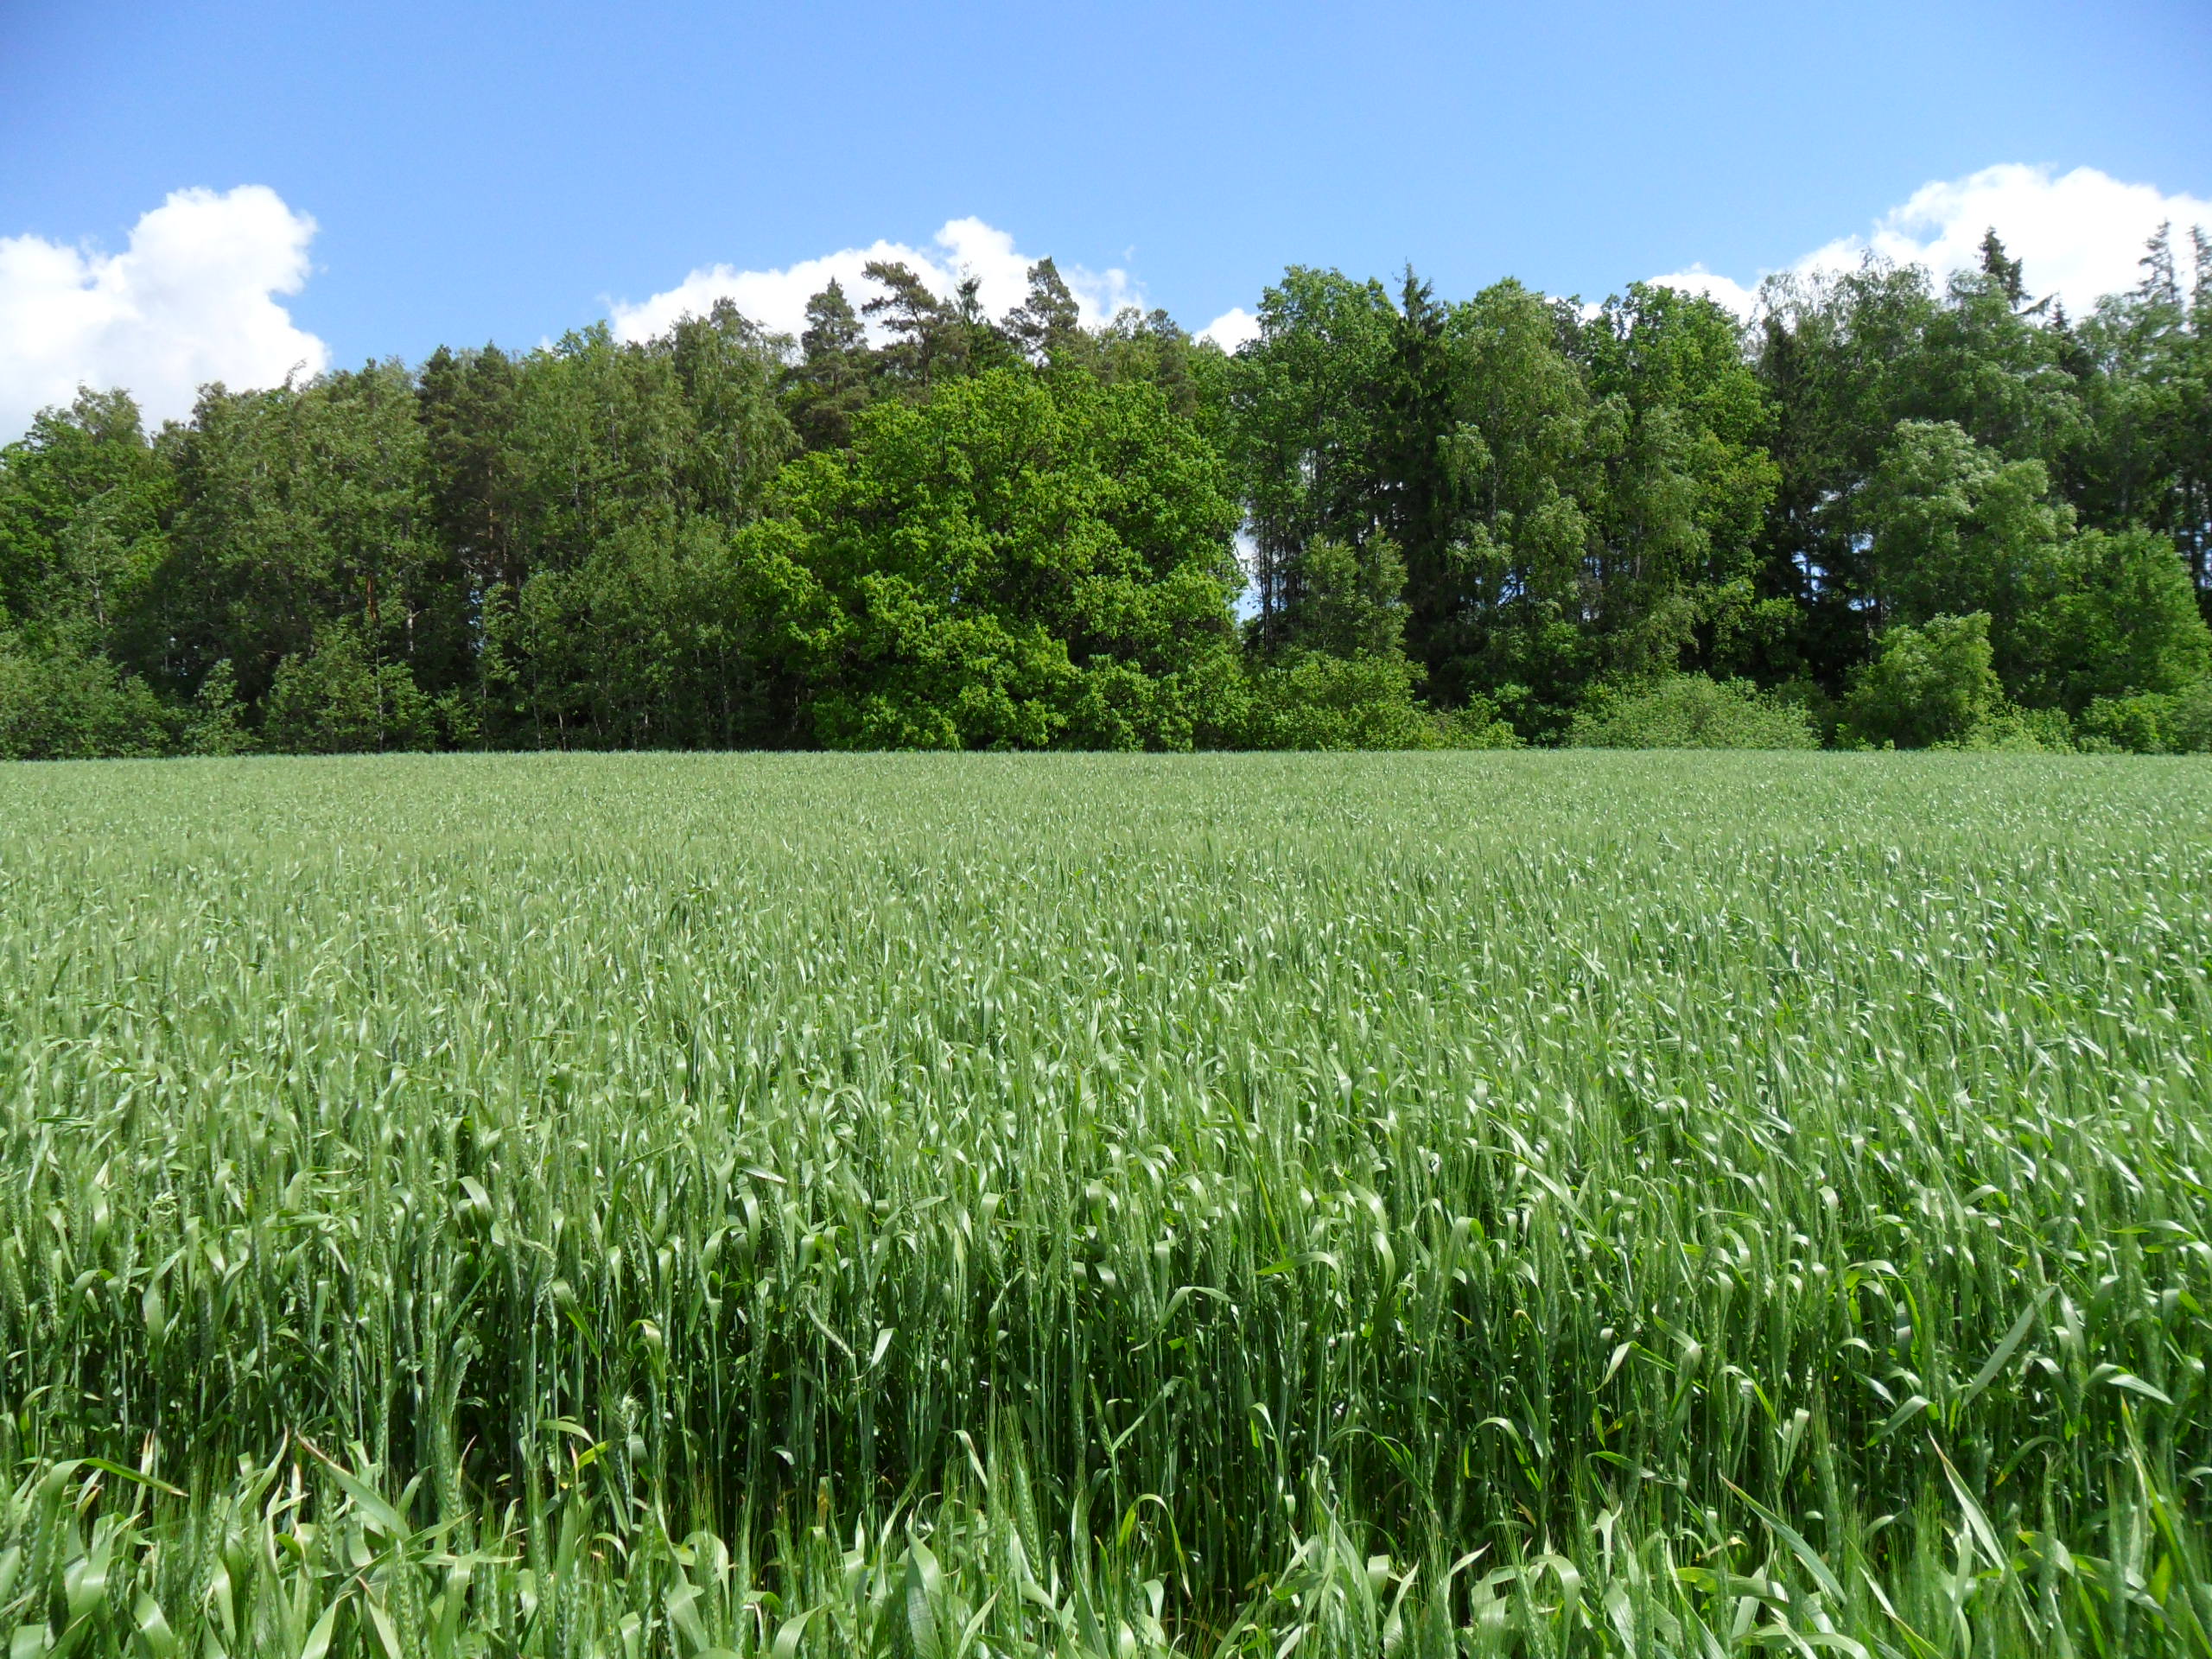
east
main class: Cropland
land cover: Triticale
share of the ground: > 75 %
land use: Agriculture (excluding fallow land and kitchen gardens)
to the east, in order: Triticale; Broadleaved woodland; Spruce dominated mixed woodland; Shrubland with sparse tree cover; Spruce dominated mixed woodland
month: June
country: LV
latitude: 57.0579
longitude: 22.9732
